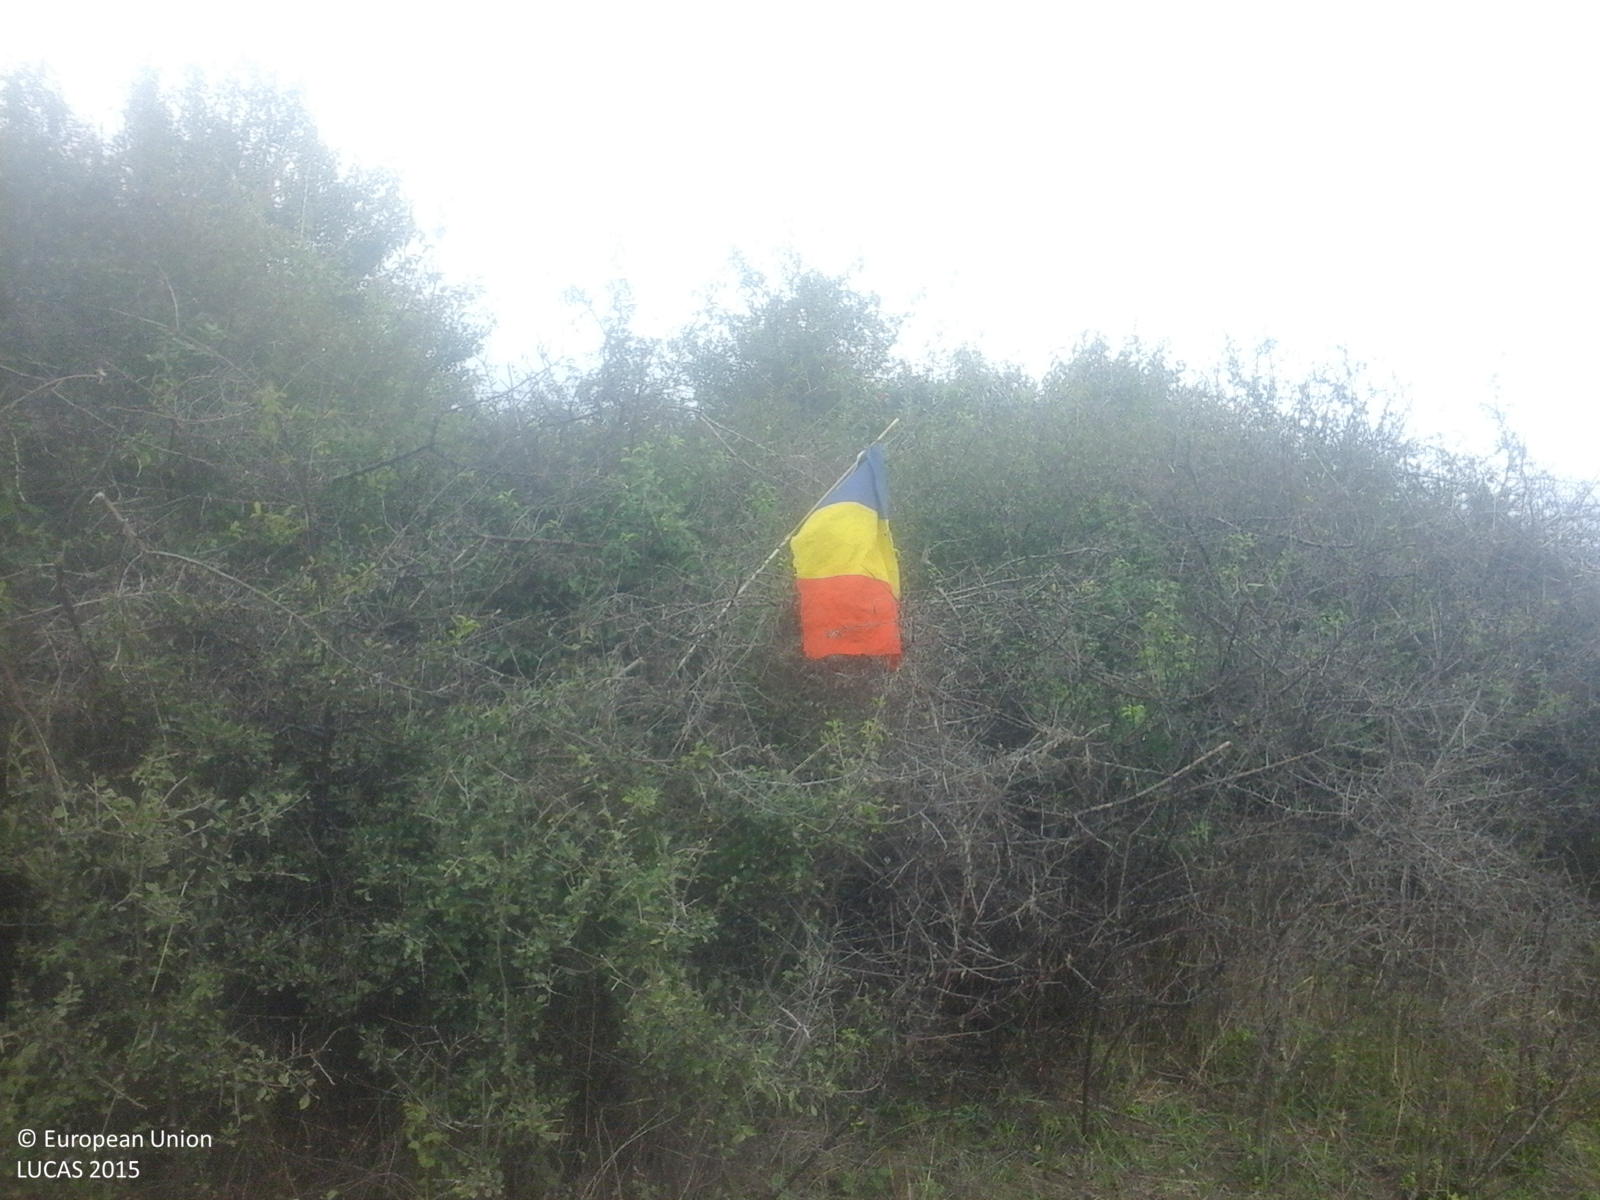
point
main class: Shrubland
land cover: Shrubland with sparse tree cover
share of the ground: > 75 %
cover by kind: shrubs 85 %, herbaceous plants 10 %, broadleaved forest trees 5 %
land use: Fallow land
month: September
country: RO
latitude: 45.9479
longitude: 23.9136
